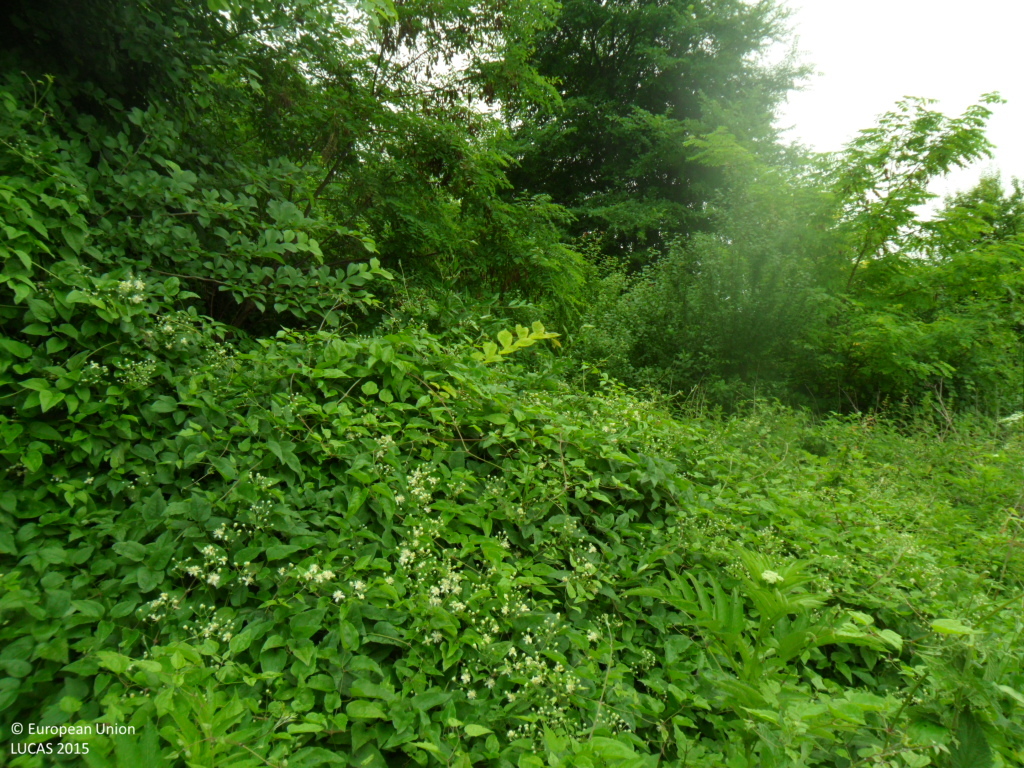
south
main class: Woodland
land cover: Broadleaved woodland
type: mesophytic deciduous forest
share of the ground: > 75 %
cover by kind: broadleaved forest trees 90 %, shrubs 10 %
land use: Forestry
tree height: > 5 m
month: June
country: BG
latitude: 43.3304
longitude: 26.9485
